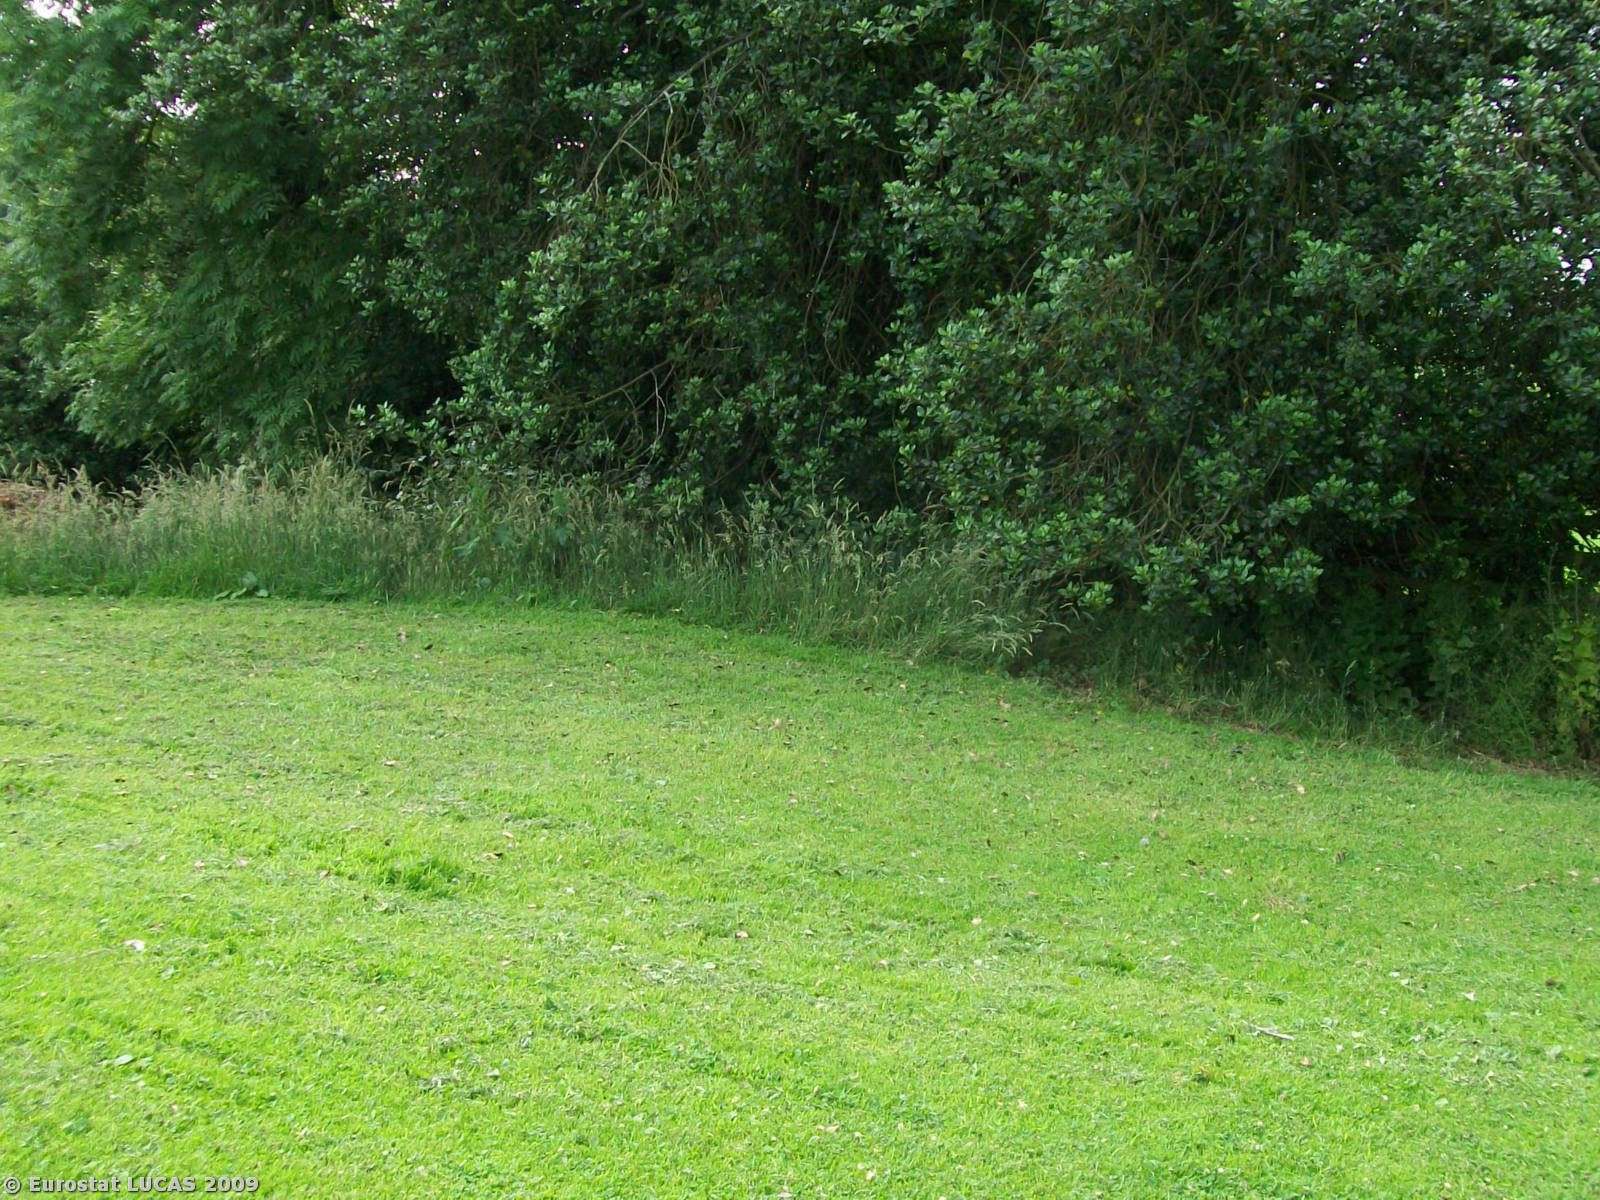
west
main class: Grassland
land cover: Grassland with sparse tree/shrub cover
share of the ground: < 10 %
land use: Holiday camps
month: June
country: GB
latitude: 54.0875
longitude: -1.4997
